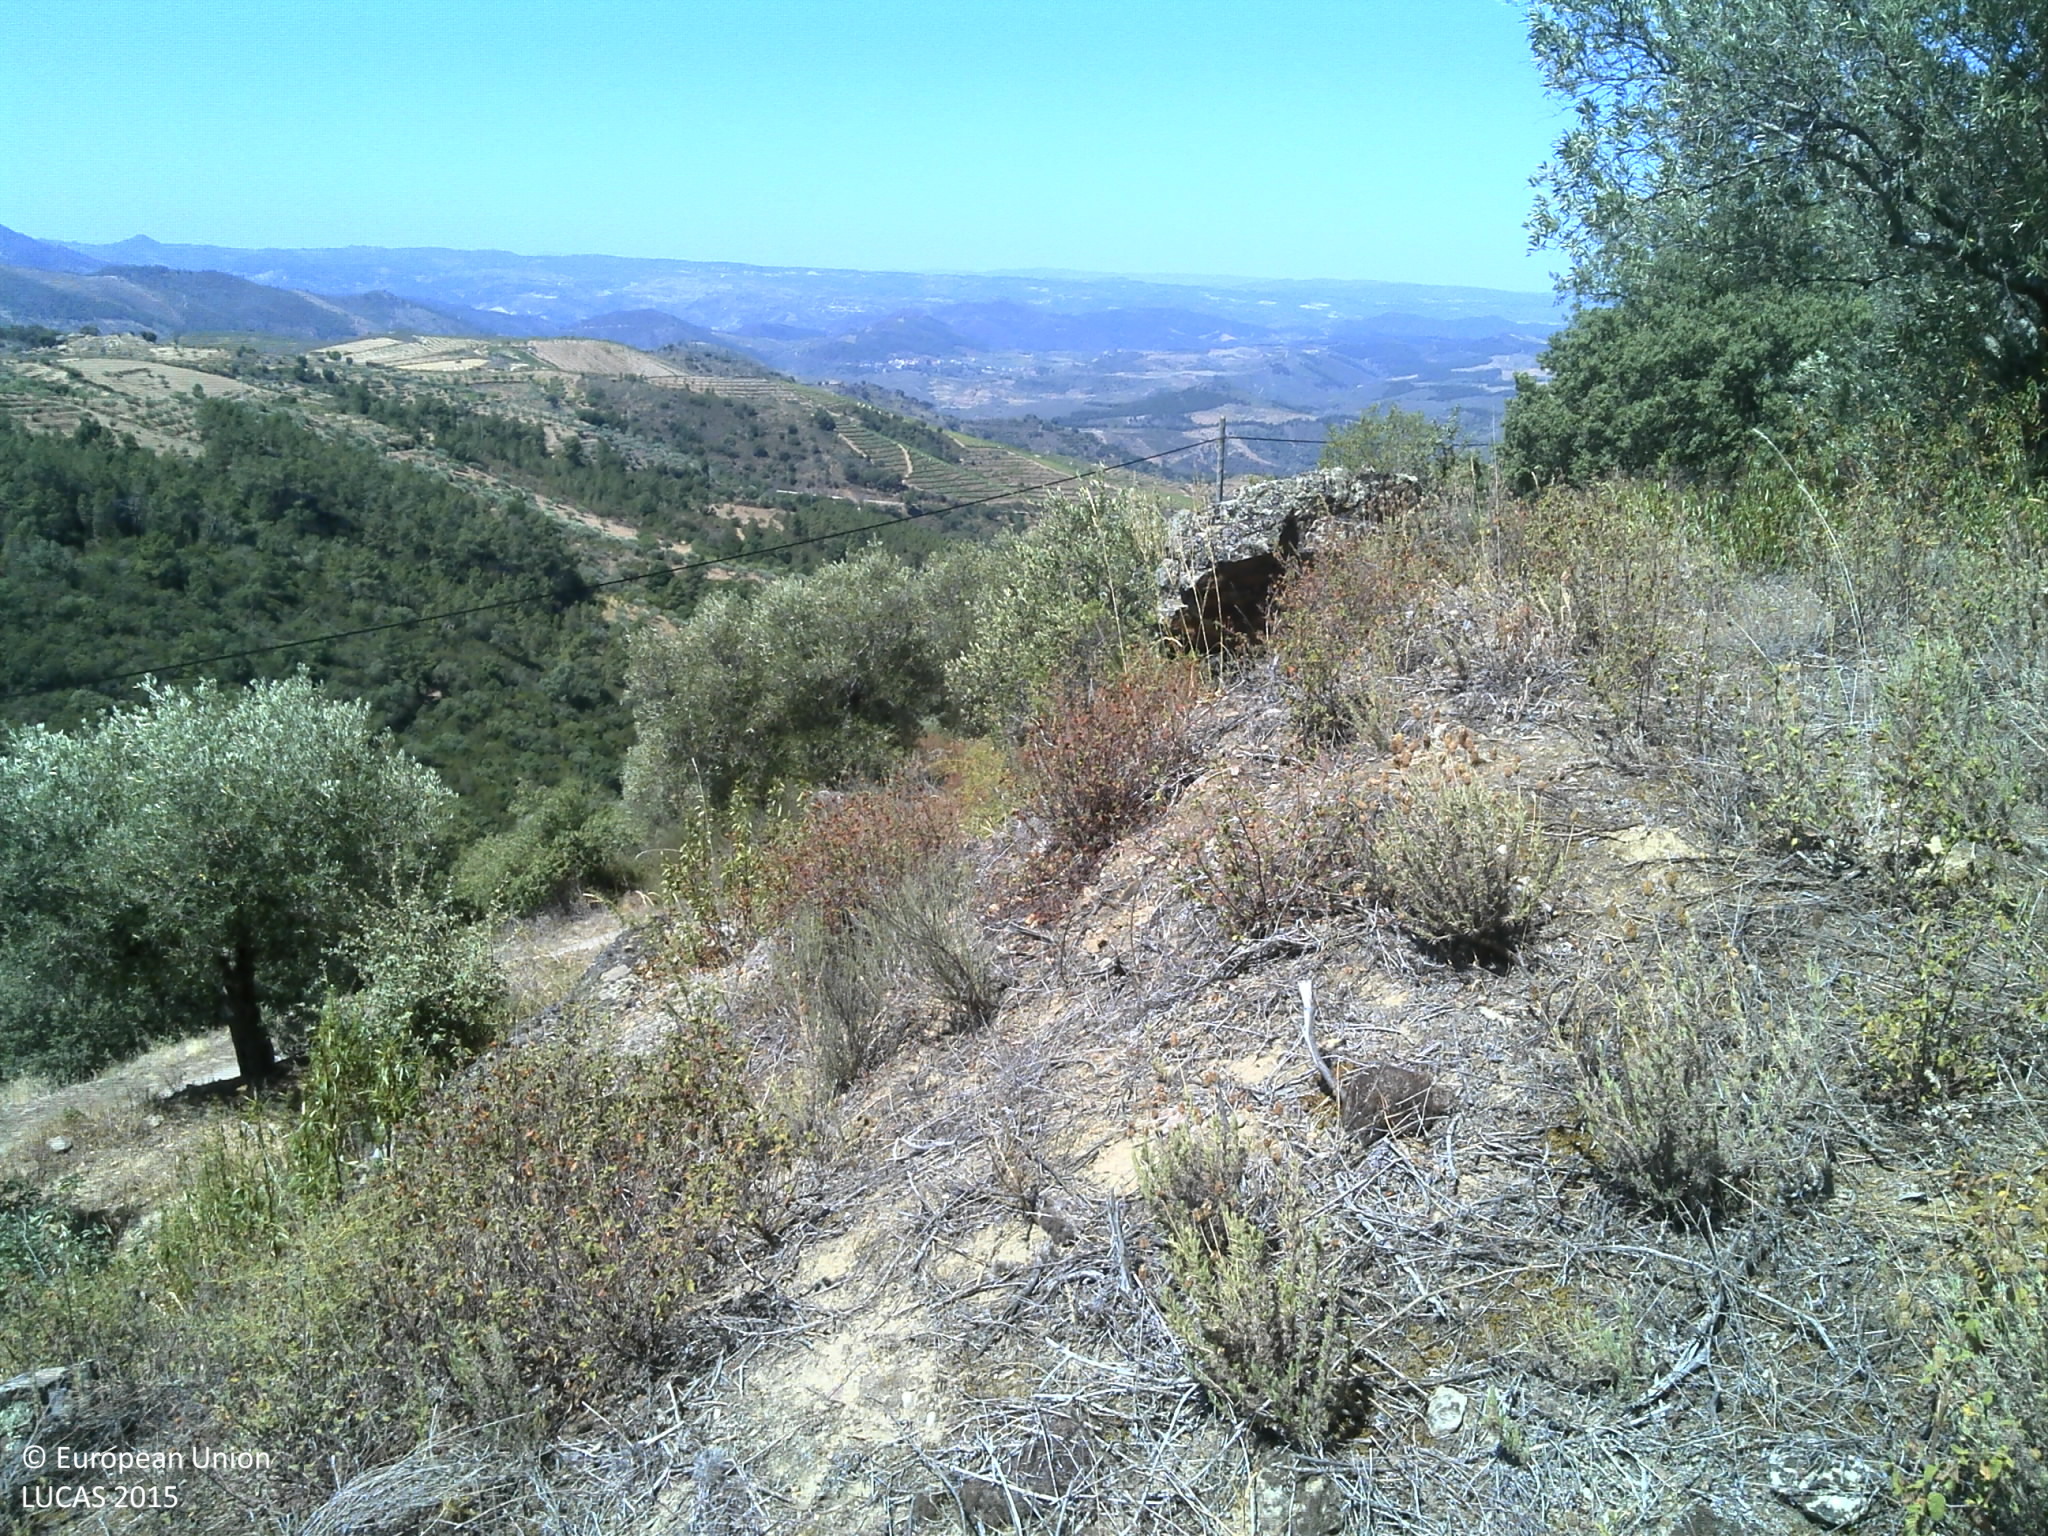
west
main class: Woodland
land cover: Pine dominated coniferous woodland
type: coniferous forest of the mediterranean region
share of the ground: 10 - 25 %
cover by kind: shrubs 35 %, unconsolidated bare surface 20 %, coniferous forest trees 15 %, herbaceous plants 10 %, consolidated bare surface 10 %
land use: Forestry
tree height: > 5 m
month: July
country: PT
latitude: 41.3543
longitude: -7.1977
